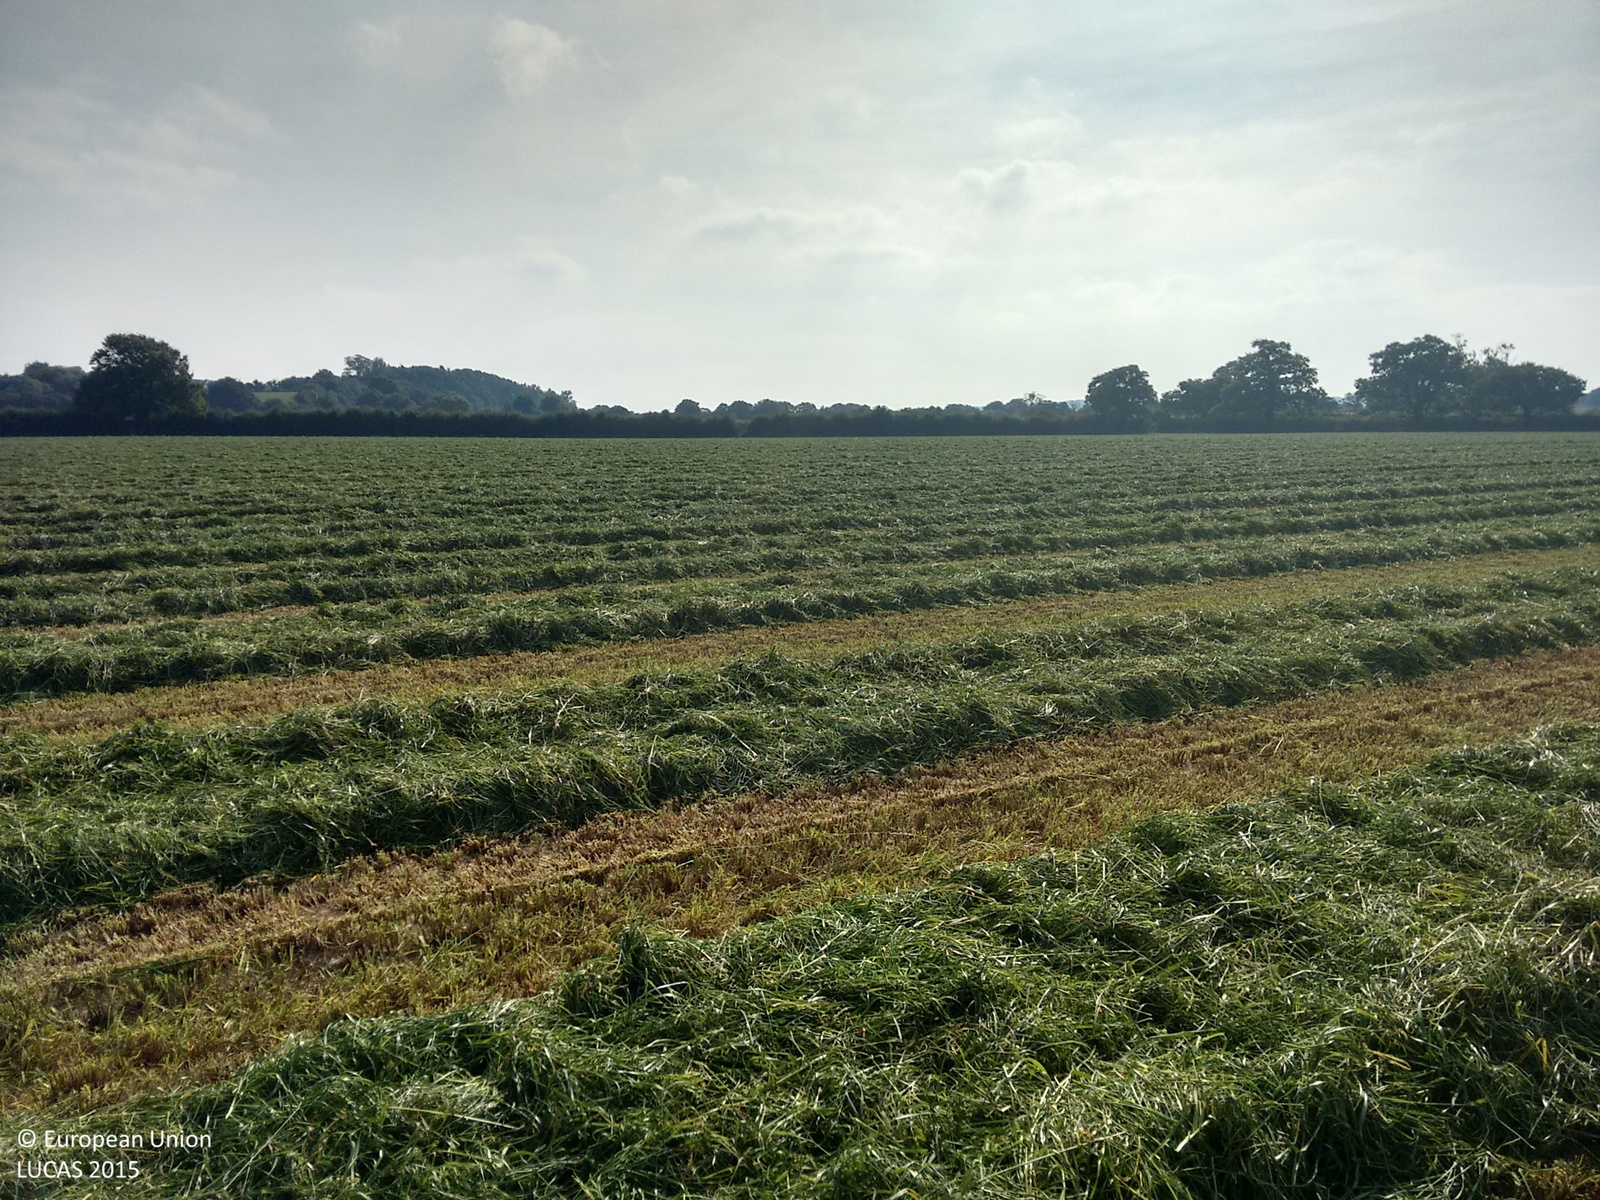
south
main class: Grassland
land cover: Grassland without tree/shrub cover
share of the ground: > 75 %
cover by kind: herbaceous plants 100 %
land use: Agriculture (excluding fallow land and kitchen gardens)
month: September
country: GB
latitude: 52.7698
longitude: -2.3208
